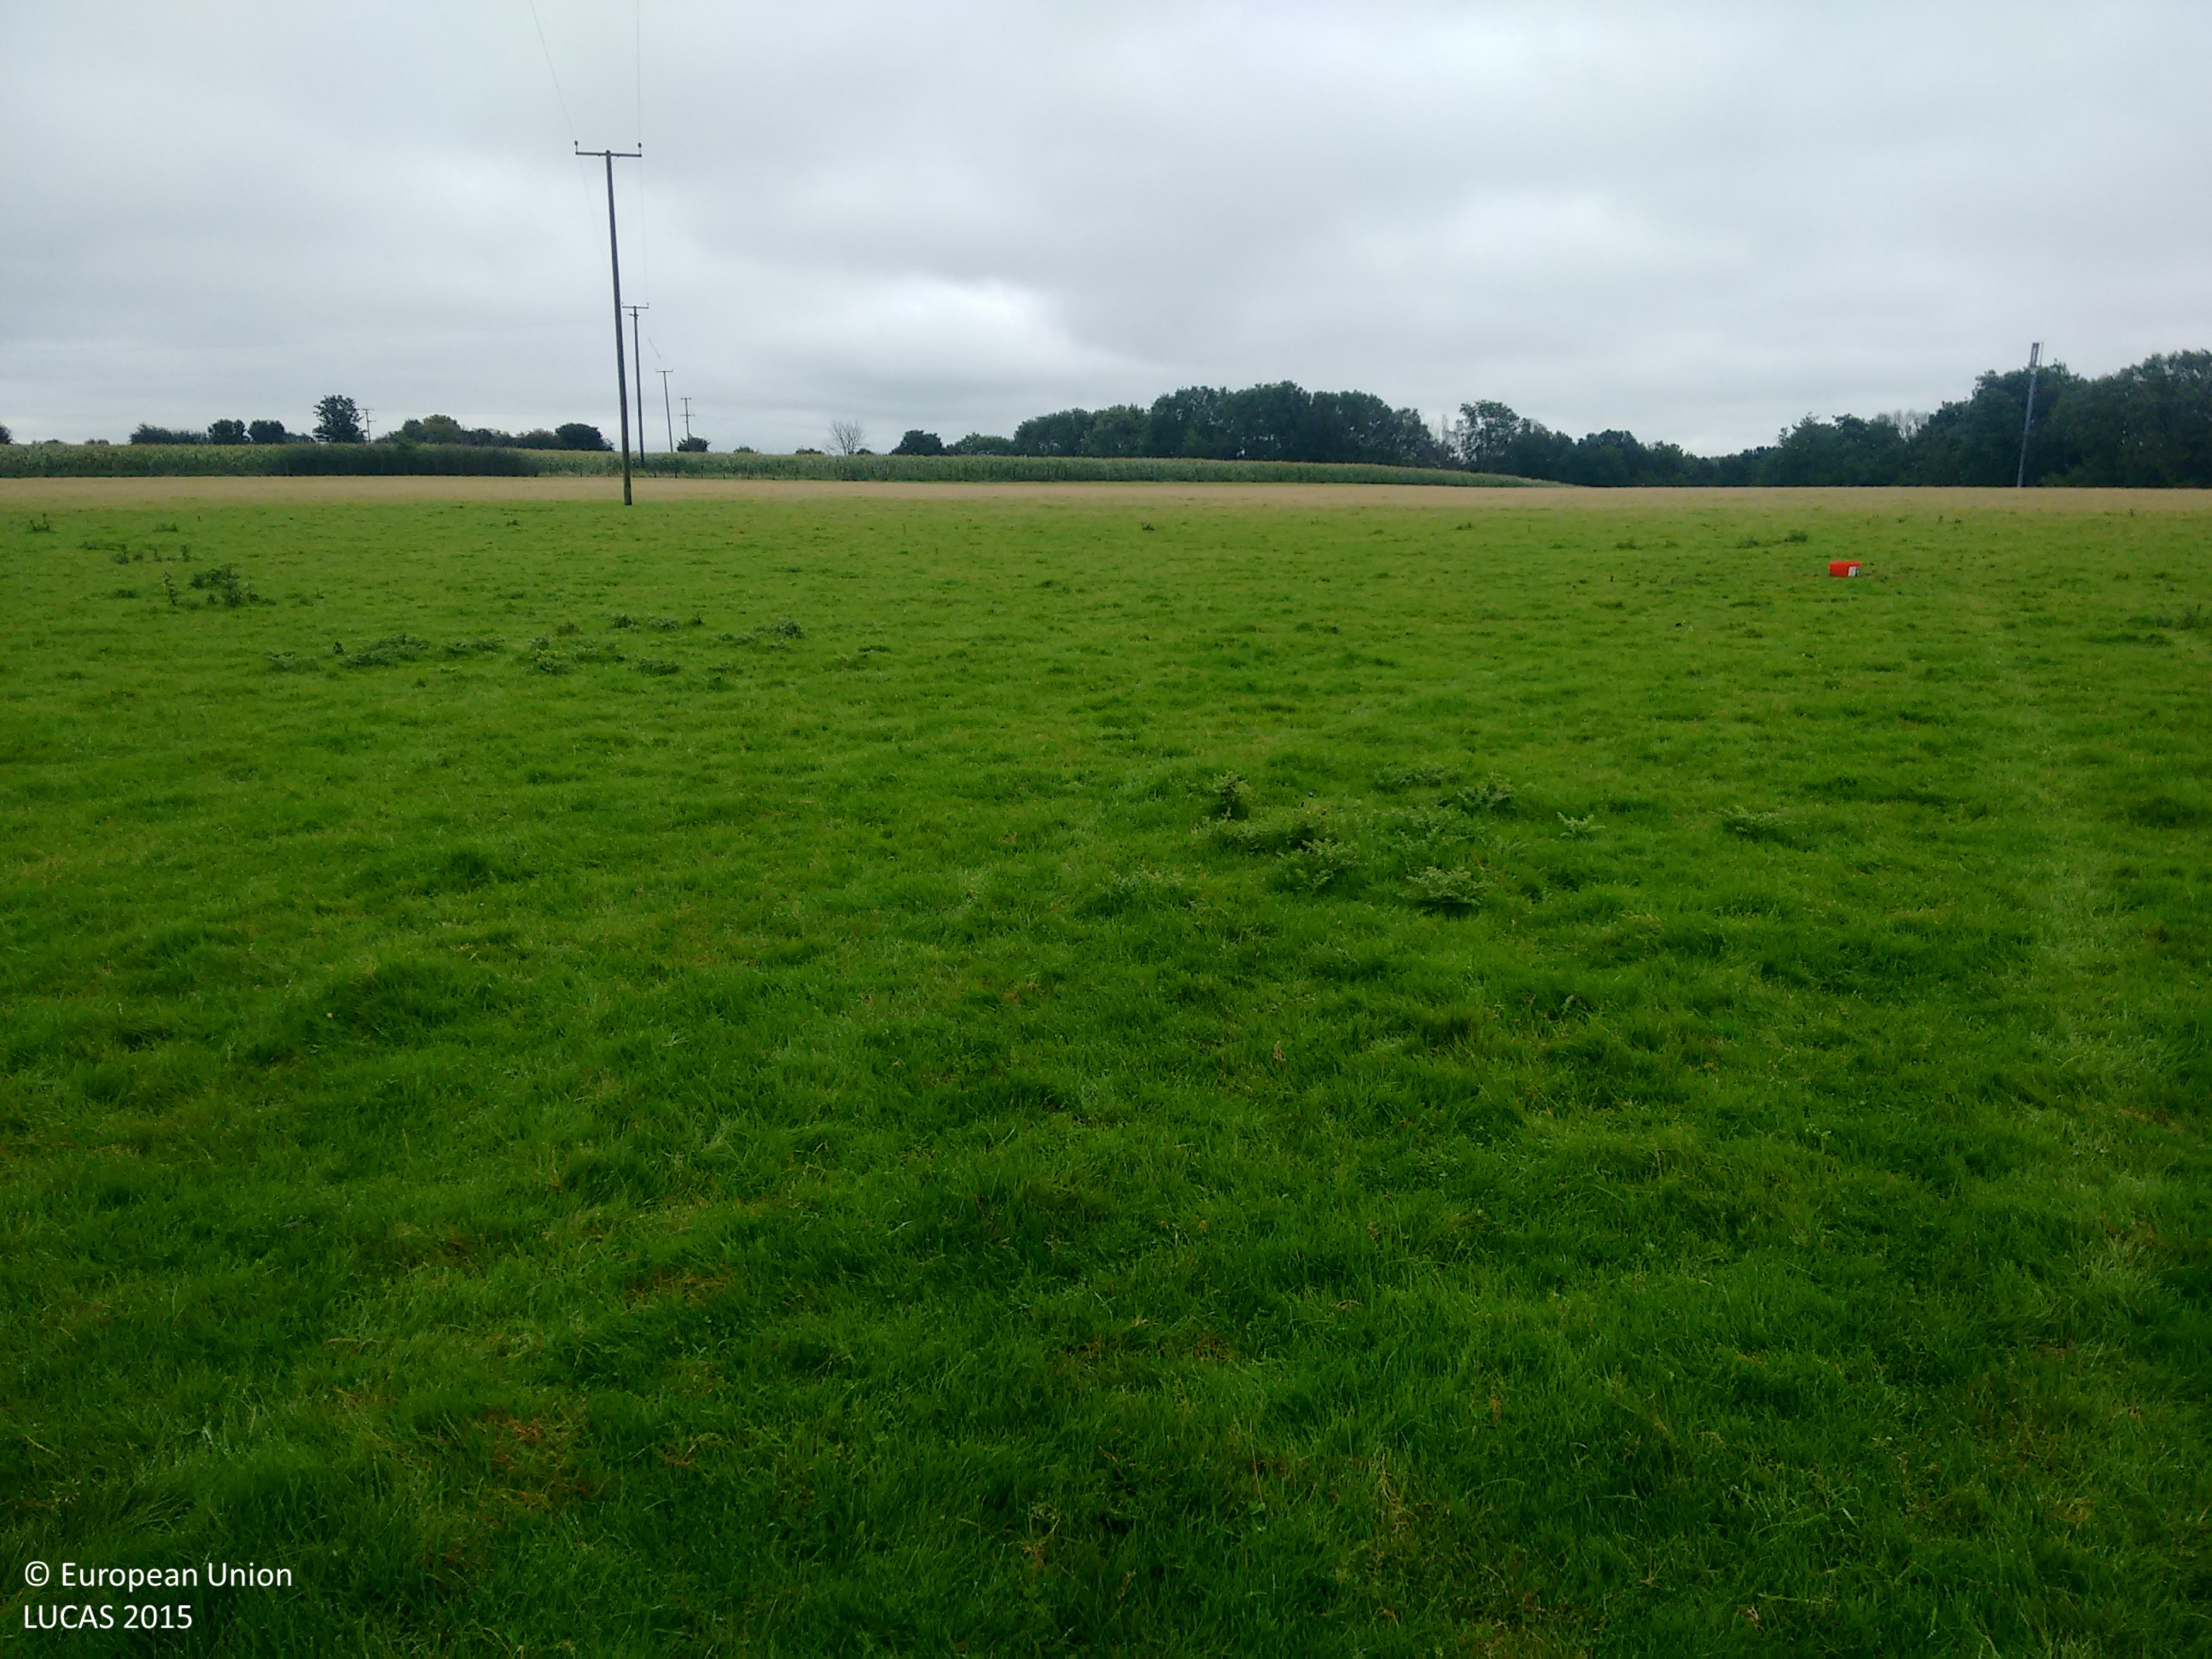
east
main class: Grassland
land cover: Grassland without tree/shrub cover
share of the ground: > 75 %
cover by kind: herbaceous plants 100 %
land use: Agriculture (excluding fallow land and kitchen gardens)
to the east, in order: Grassland without tree/shrub cover; Electric lines; Grassland without tree/shrub cover; Fences; Maize
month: October
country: GB
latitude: 51.3185
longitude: 0.6325
